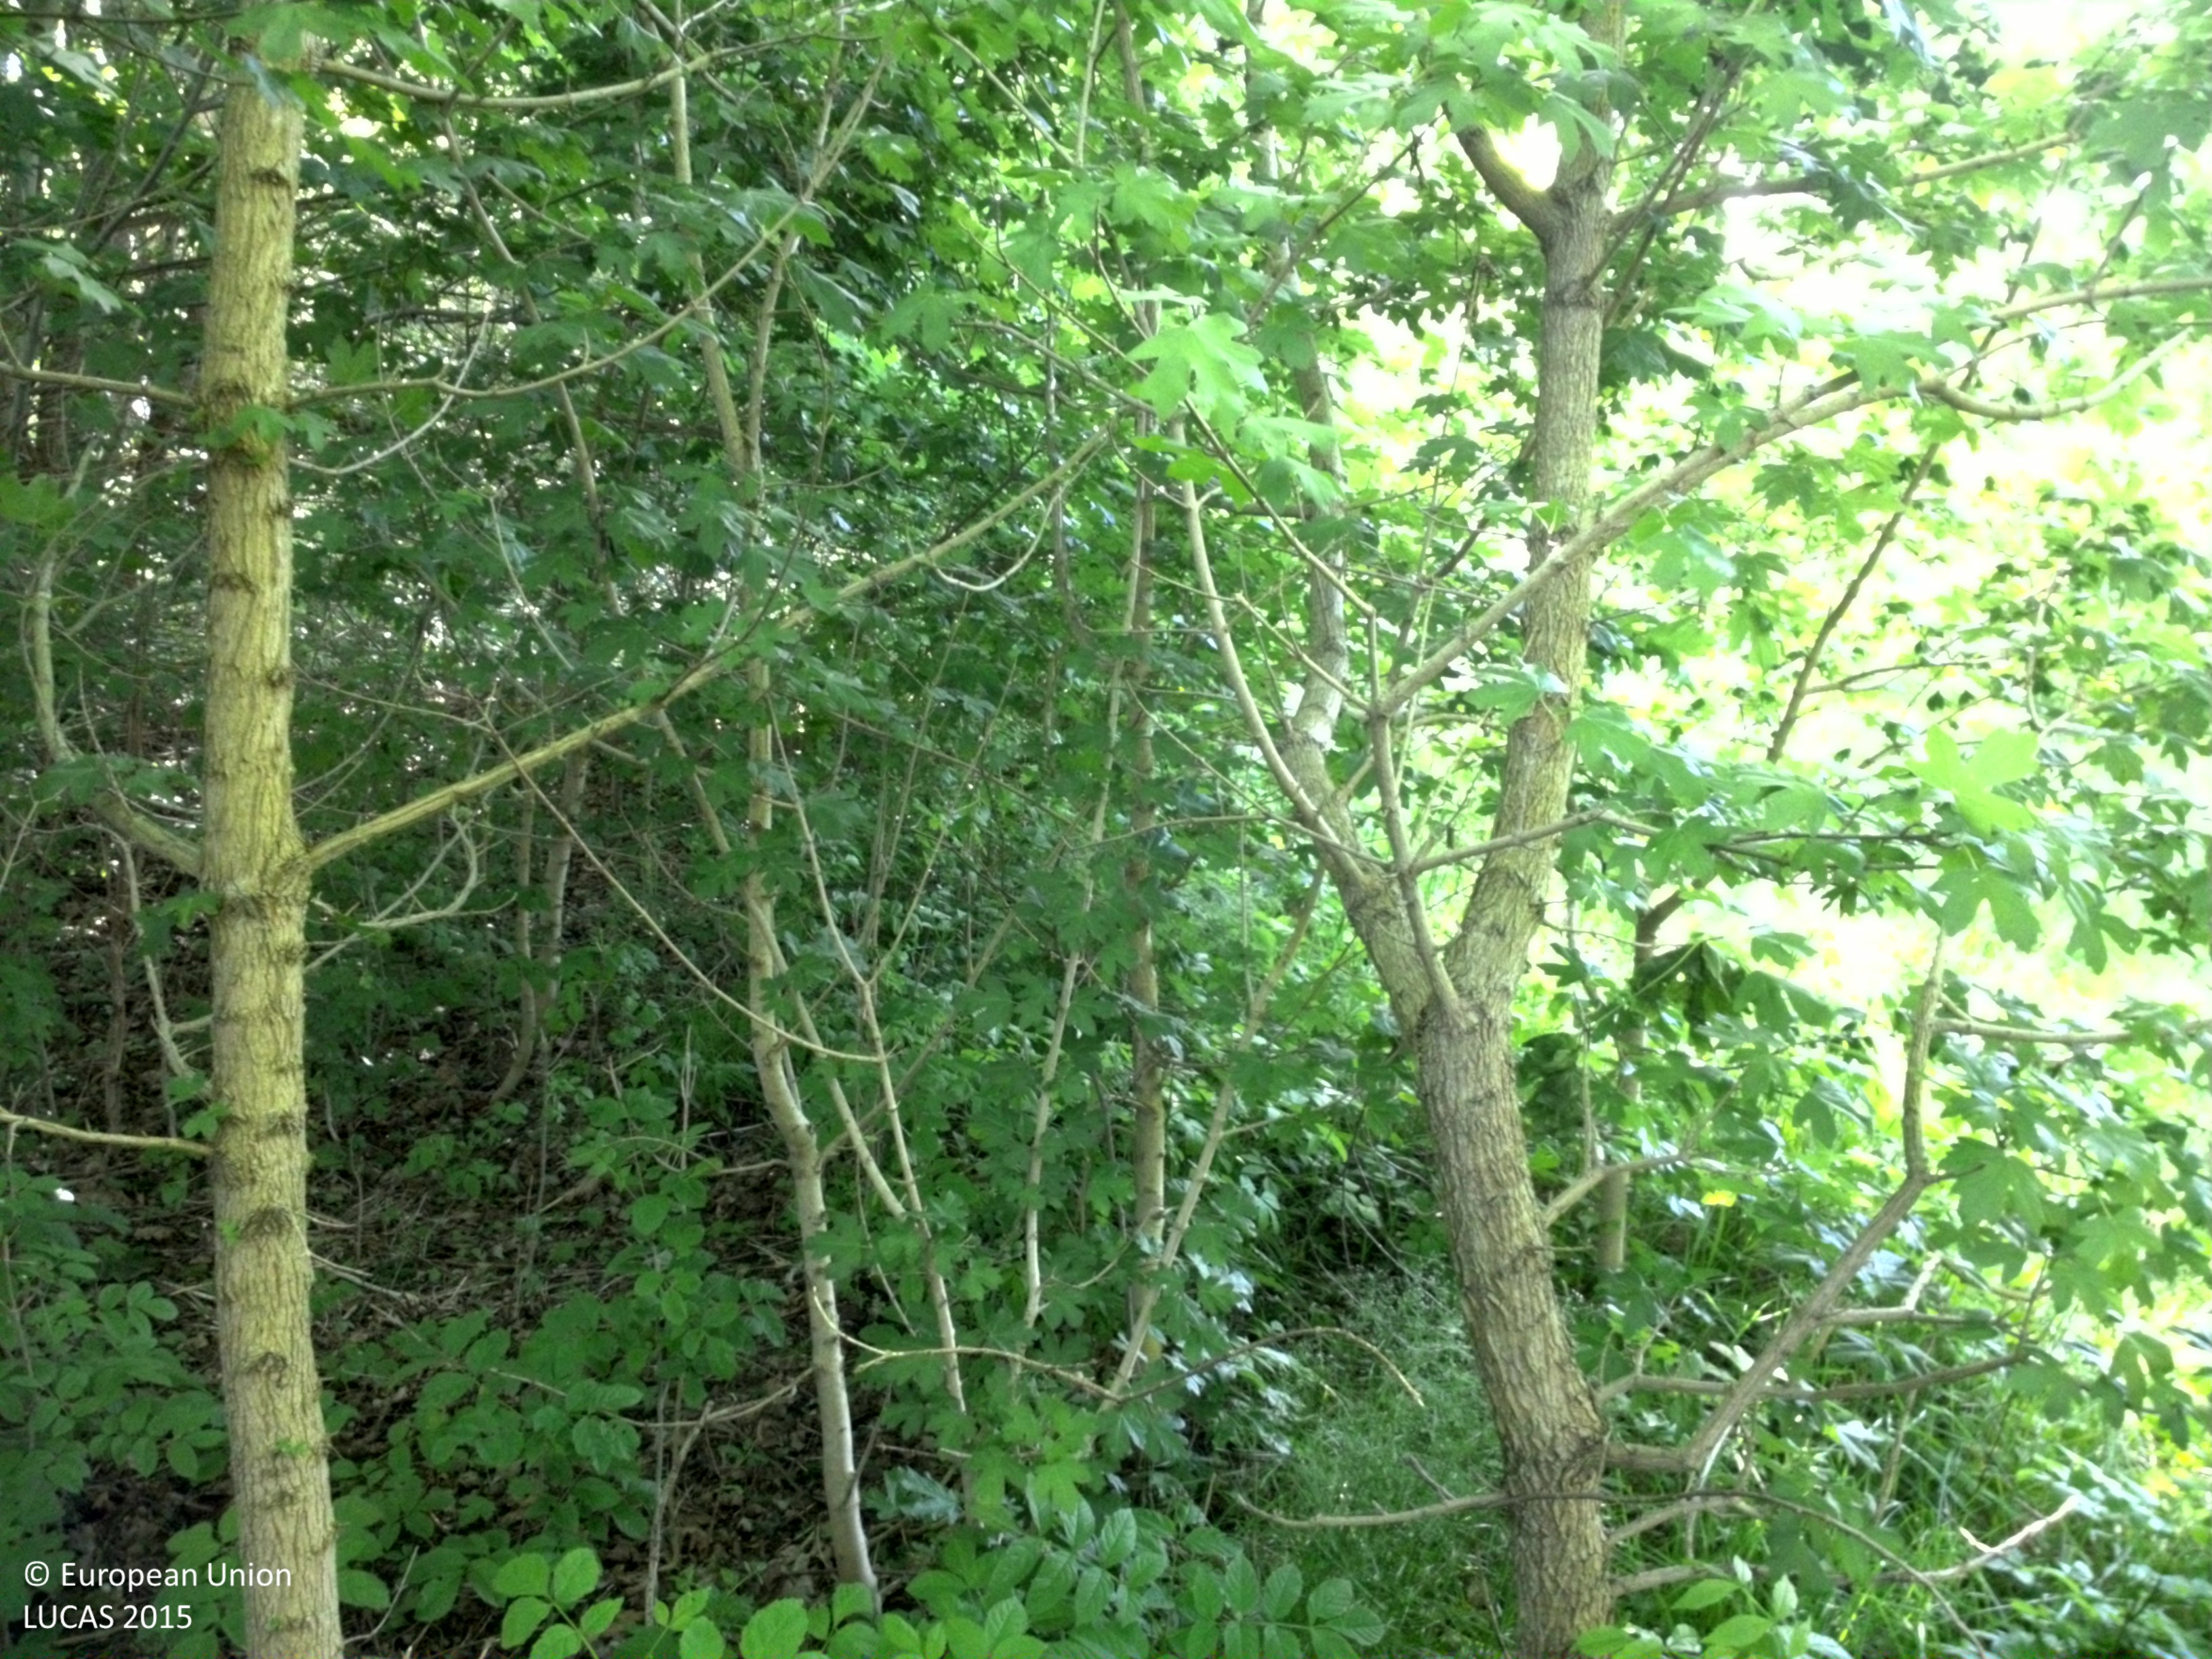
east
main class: Woodland
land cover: Broadleaved woodland
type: hemiboreal forest and nemoral coniferous forest and mixed broadleaved-coniferous forest
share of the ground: > 75 %
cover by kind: broadleaved forest trees 85 %, herbaceous plants 10 %, consolidated bare surface 5 %
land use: Amenities, museums, leisure
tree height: > 5 m
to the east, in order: Broadleaved woodland; Paved roads, cycling and walking lanes; Broadleaved woodland; Tracks; Broadleaved woodland; Tracks; Broadleaved woodland; Tracks; Broadleaved woodland; Tracks; Grassland without tree/shrub cover; Broadleaved woodland
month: June
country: SE
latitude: 58.6369
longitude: 16.1791
